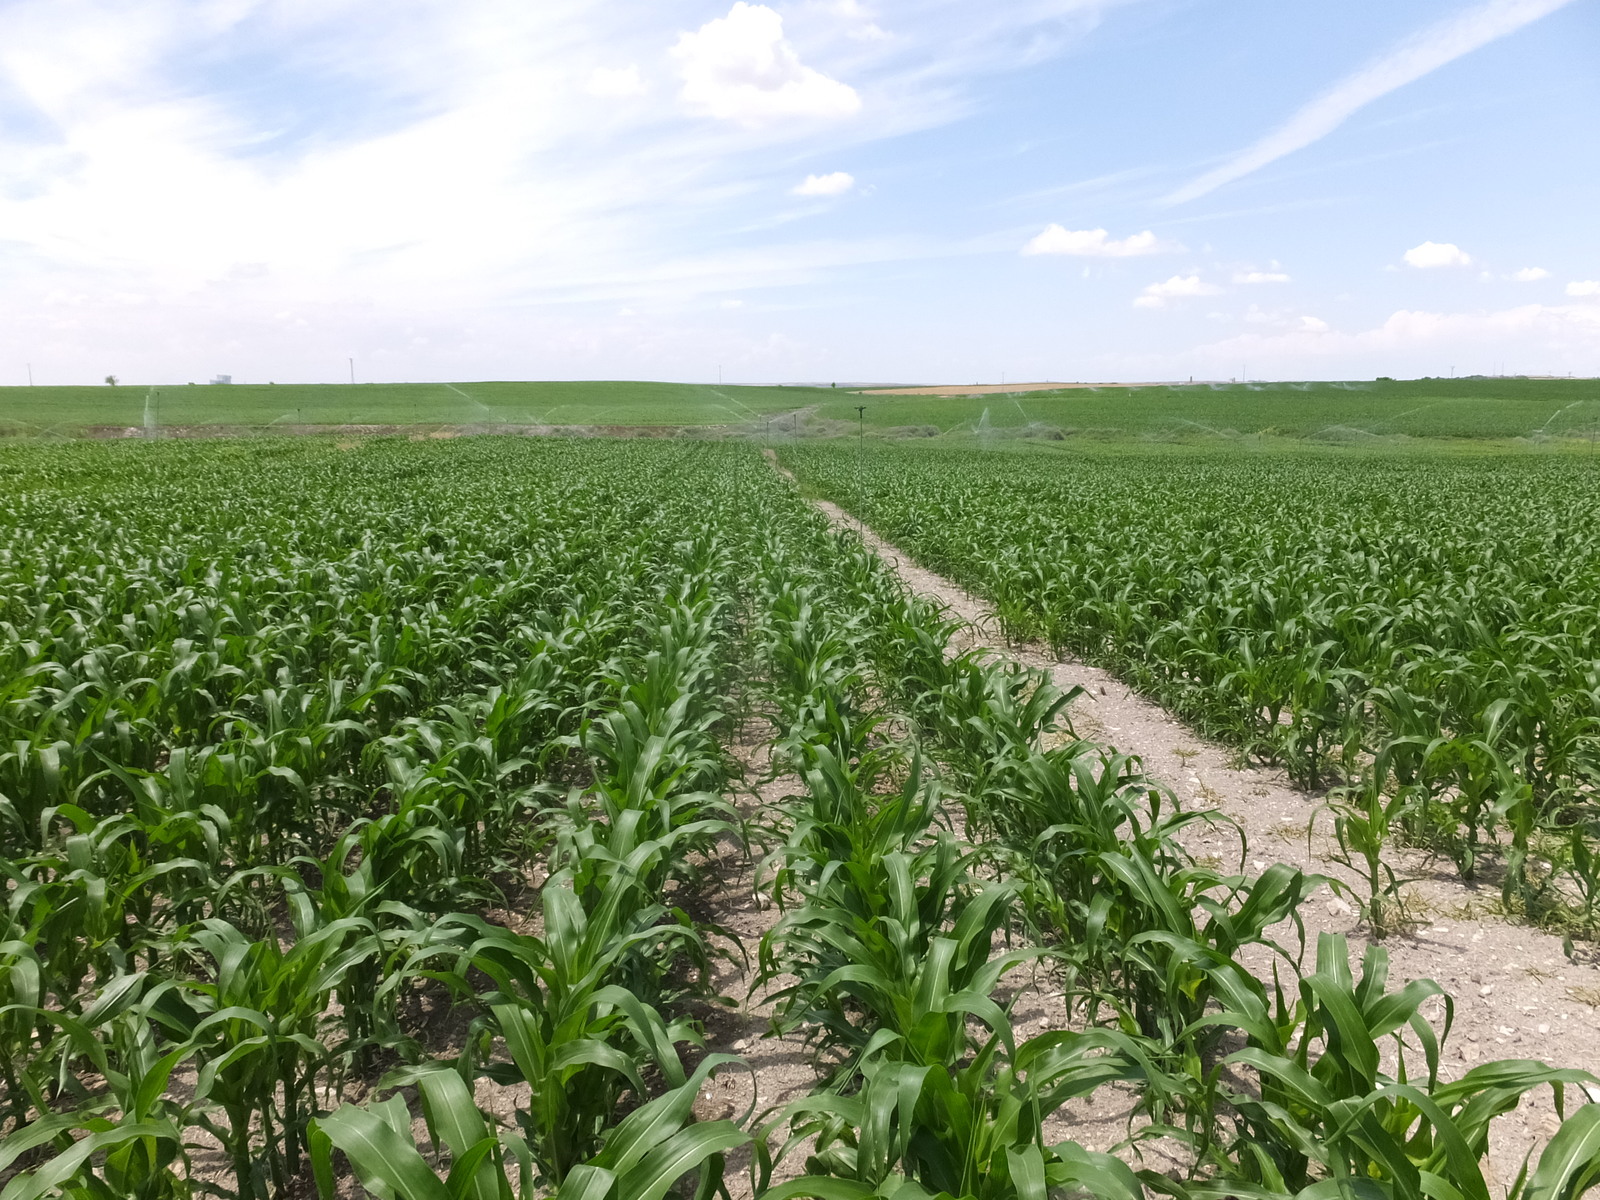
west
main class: Cropland
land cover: Maize
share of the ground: 50 - 75 %
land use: Agriculture (excluding fallow land and kitchen gardens)
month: June
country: ES
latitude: 41.4917
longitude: -0.1126
